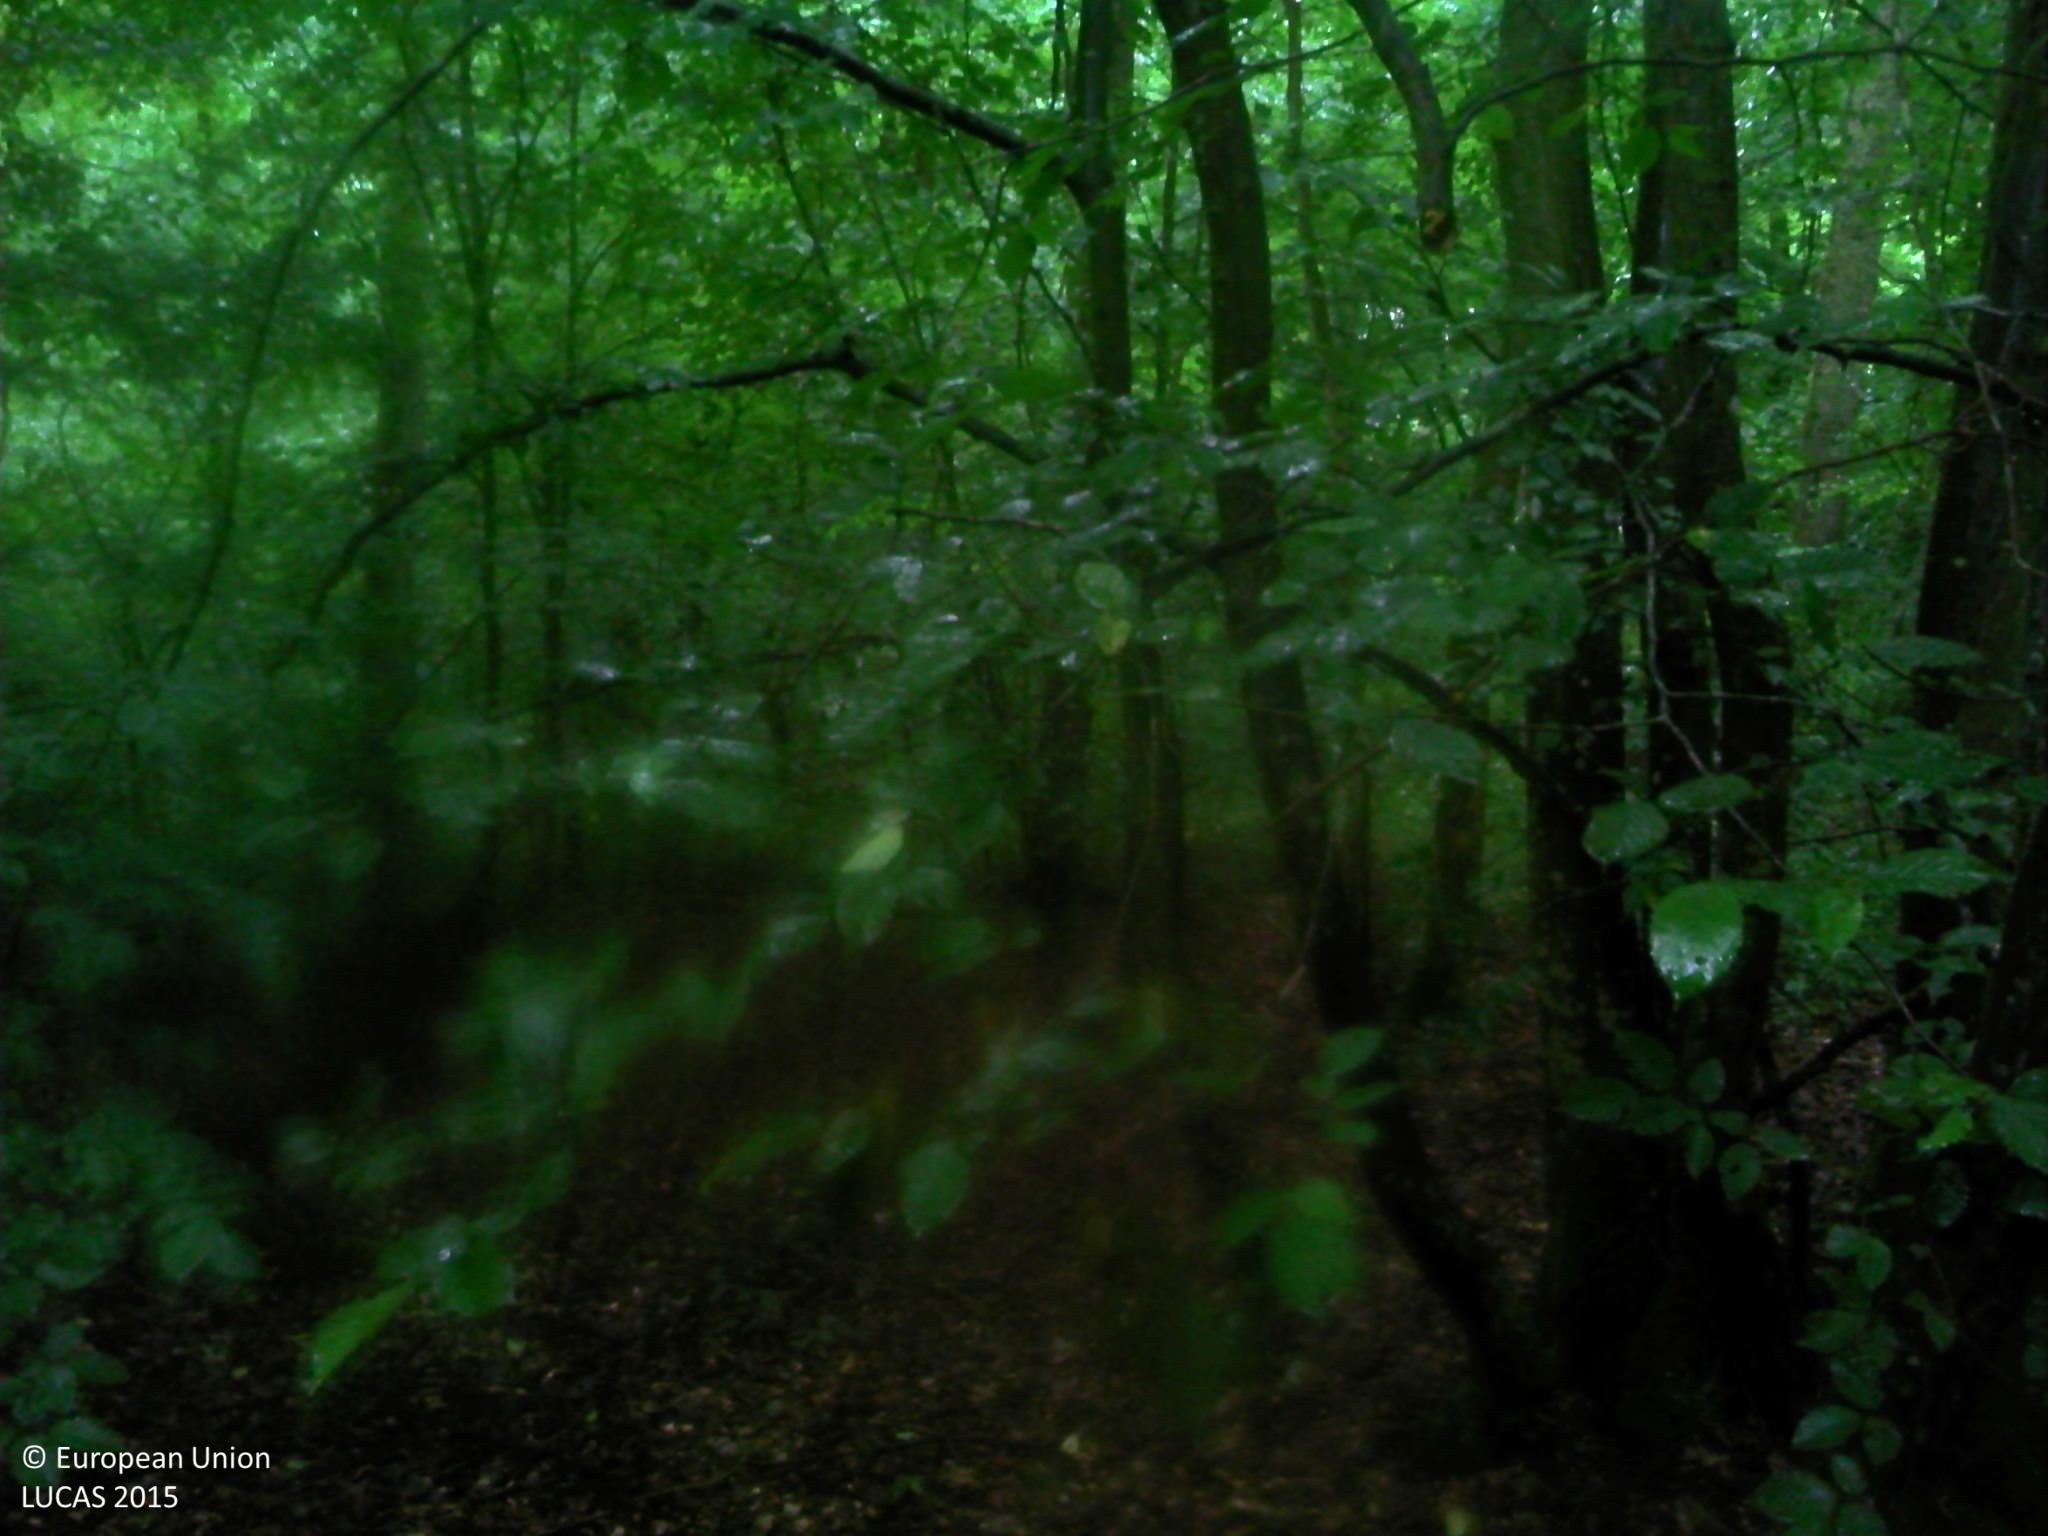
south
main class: Woodland
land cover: Broadleaved woodland
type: mesophytic deciduous forest
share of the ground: > 75 %
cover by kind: broadleaved forest trees 100 %
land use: Forestry
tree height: > 5 m
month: July
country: BE
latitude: 50.1302
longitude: 4.6385
